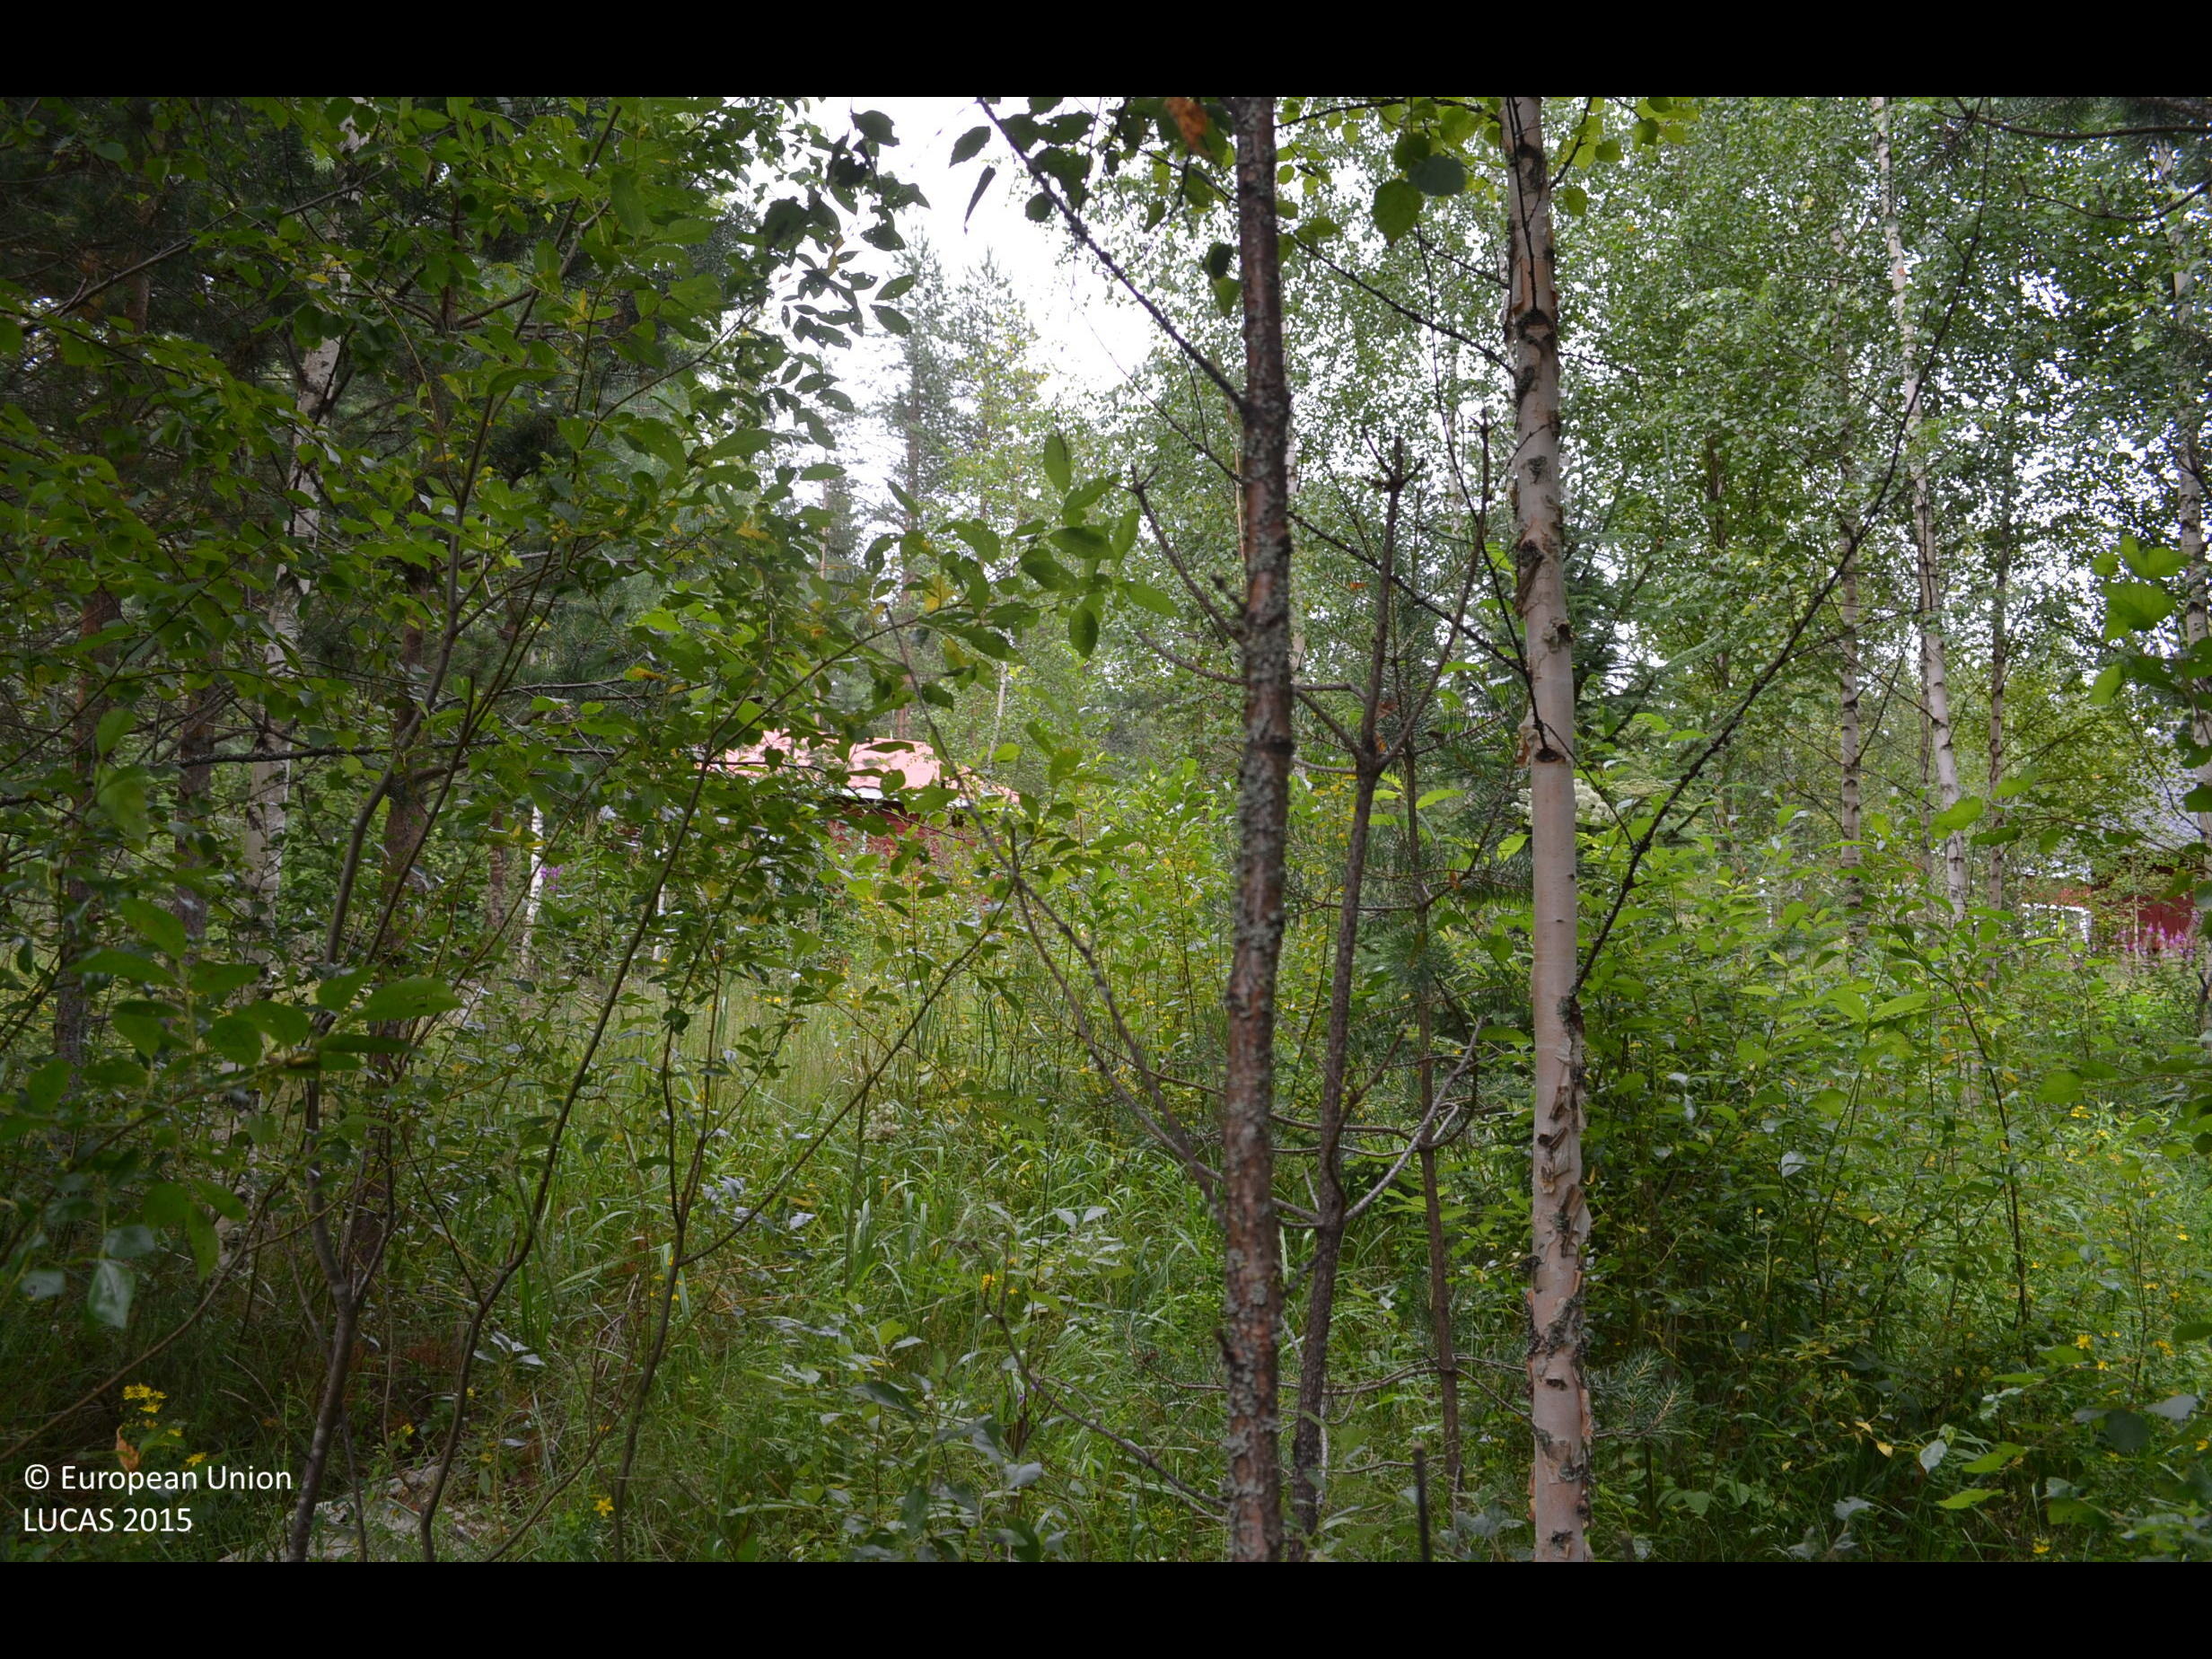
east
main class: Woodland
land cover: Pine dominated mixed woodland
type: boreal forest
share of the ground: 50 - 75 %
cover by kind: coniferous forest trees 30 %, broadleaved forest trees 30 %, herbaceous plants 30 %, shrubs 10 %
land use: Forestry
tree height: > 5 m
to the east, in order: Pine dominated mixed woodland; Grassland without tree/shrub cover; Artificial constructions in urban areas; Spruce dominated mixed woodland; Shrubland without tree cover; Other coniferous woodland
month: August
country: FI
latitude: 61.8776
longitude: 24.2197
